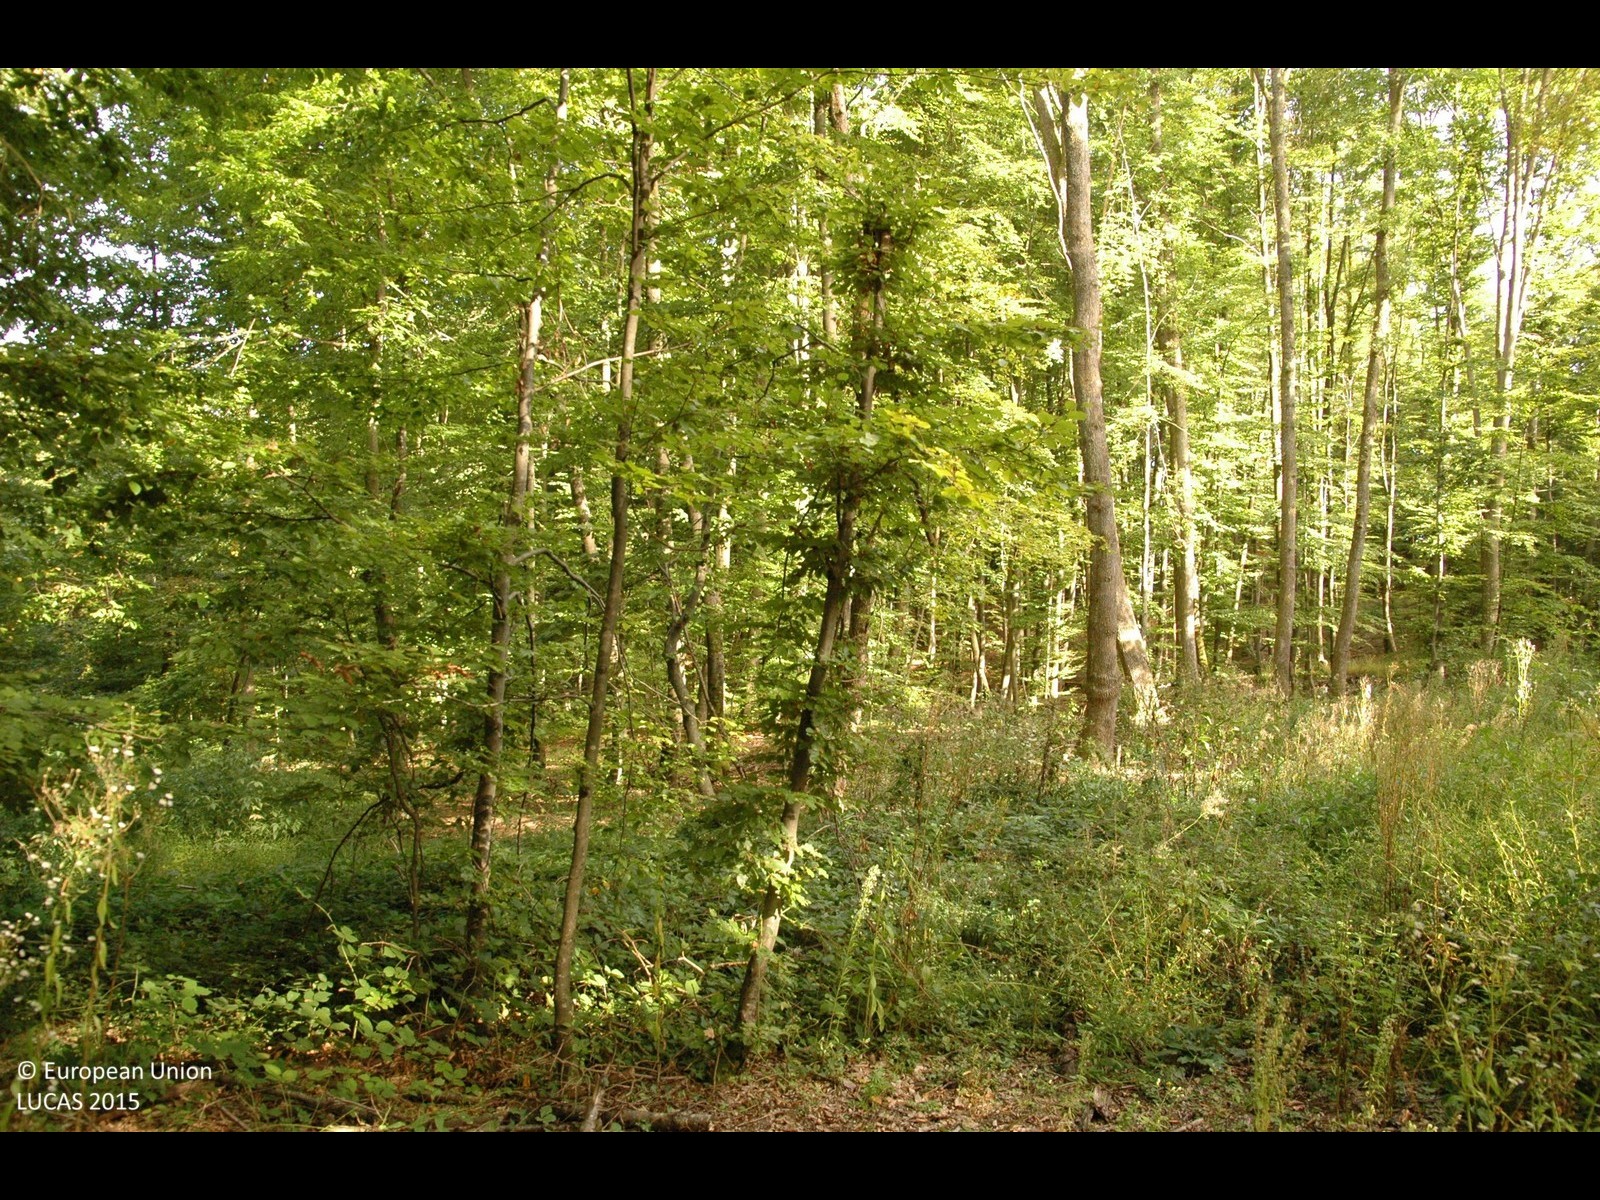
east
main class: Woodland
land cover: Broadleaved woodland
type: mesophytic deciduous forest
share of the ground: > 75 %
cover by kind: broadleaved forest trees 100 %
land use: Forestry
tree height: > 5 m
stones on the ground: < 10 %
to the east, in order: Broadleaved woodland
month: September
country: HR
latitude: 45.6472
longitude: 15.8867
